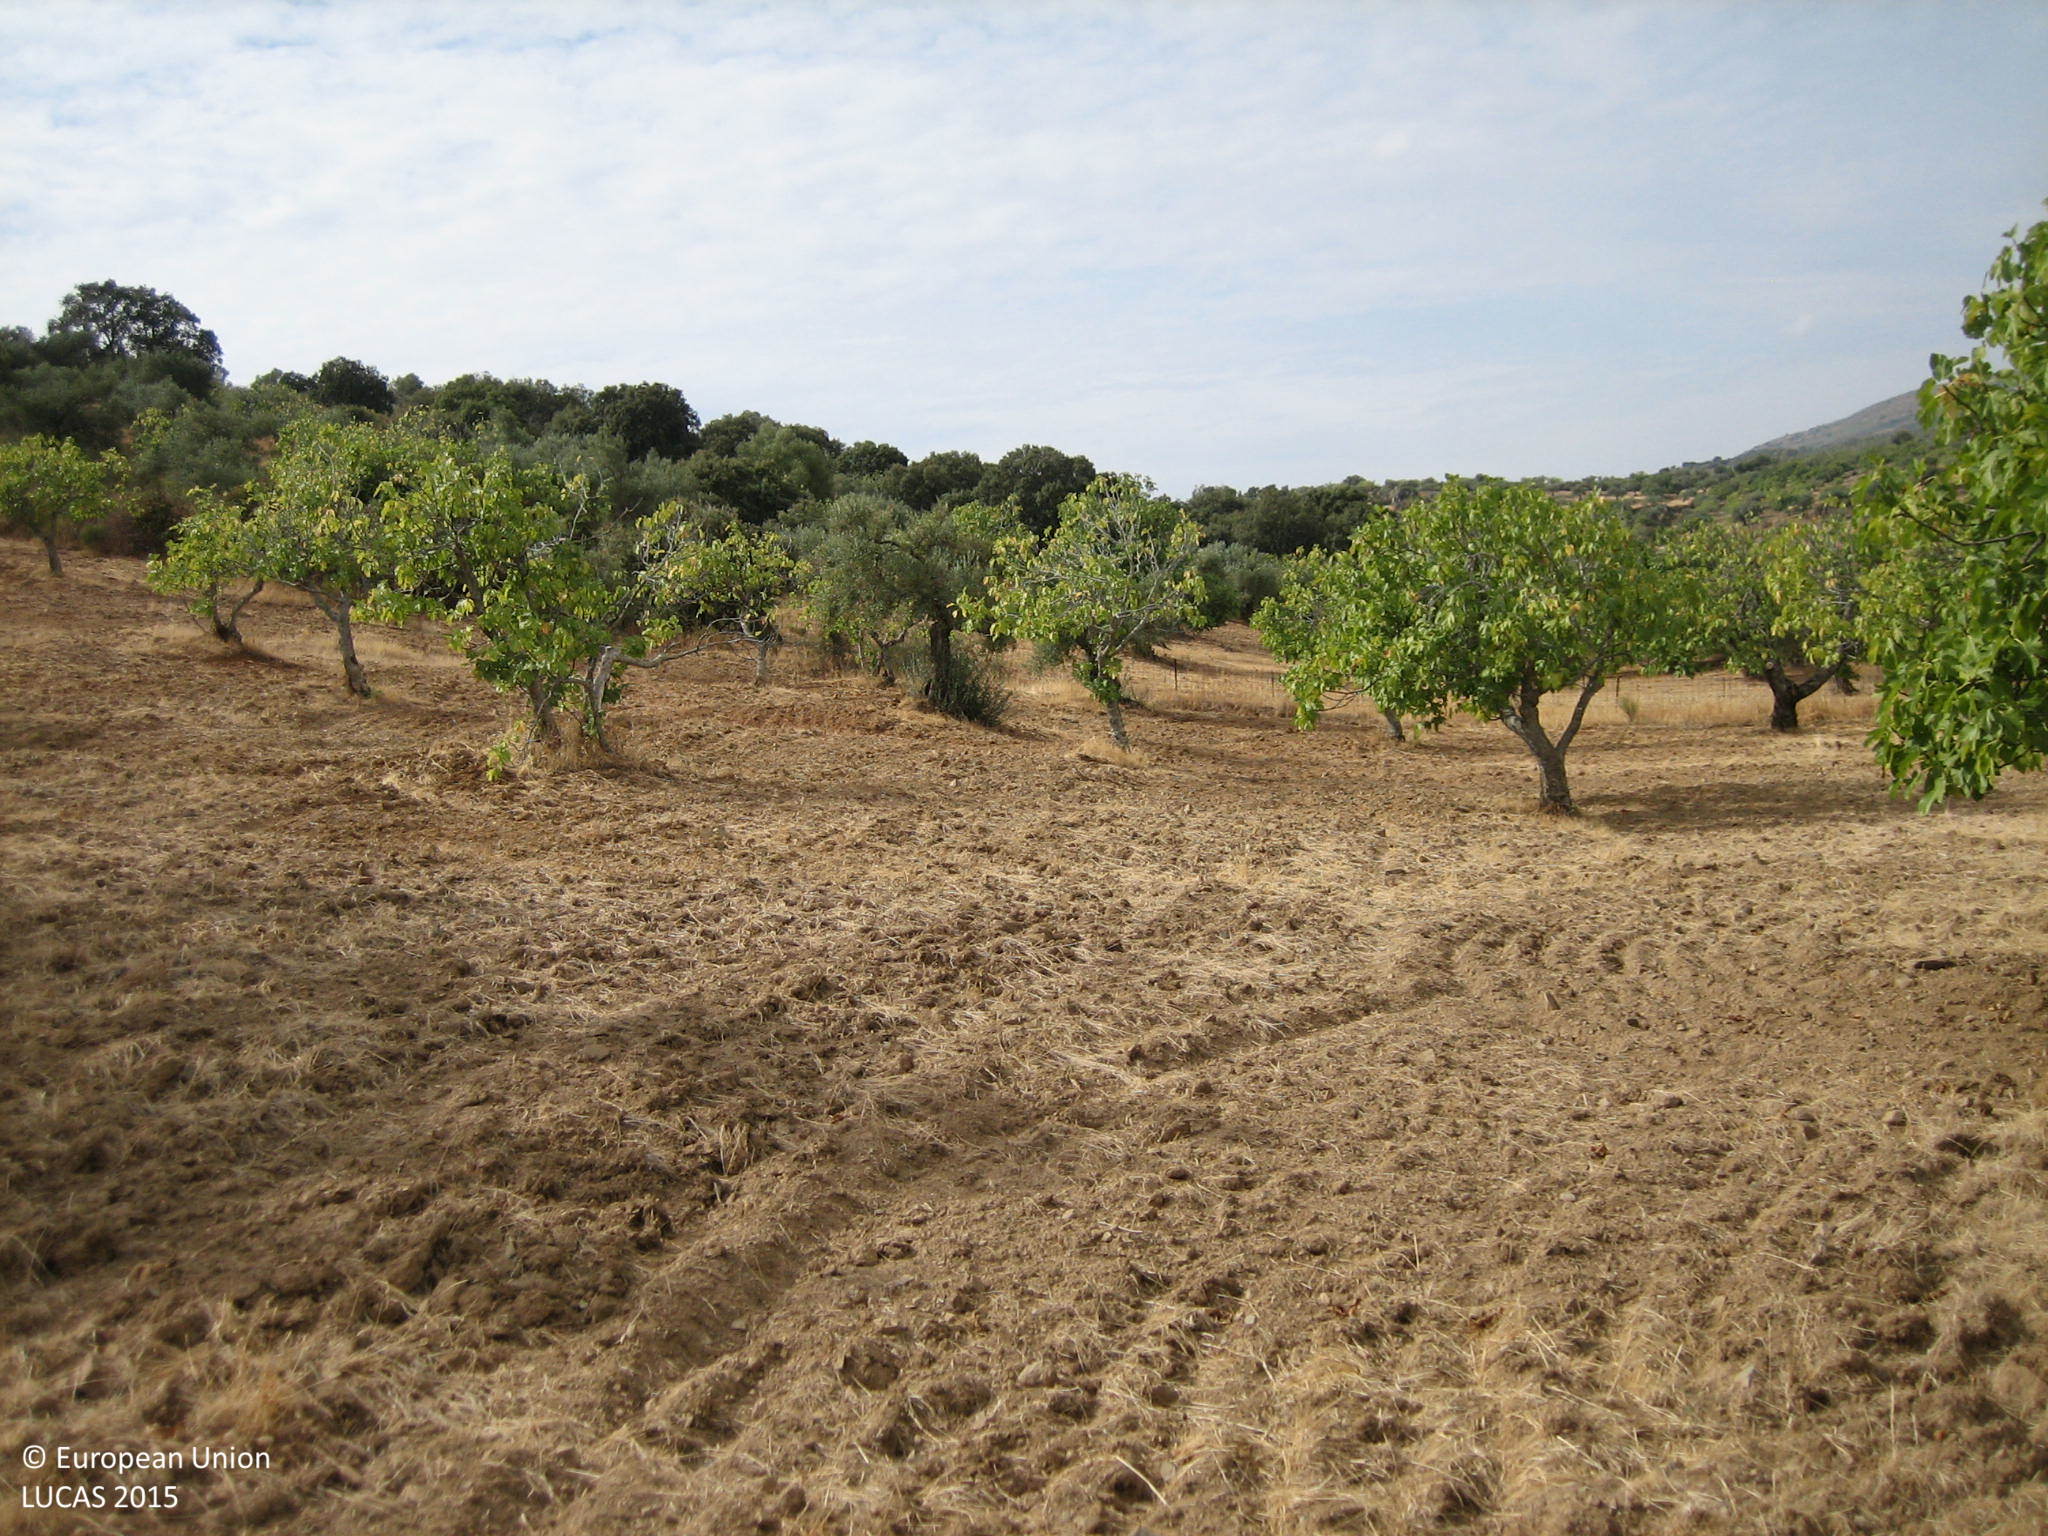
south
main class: Cropland
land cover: Other fruit trees and berries
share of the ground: 25 - 50 %
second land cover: Other bare soil
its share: > 75 %
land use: Agriculture (excluding fallow land and kitchen gardens)
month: September
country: ES
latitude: 38.5173
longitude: -6.7695
